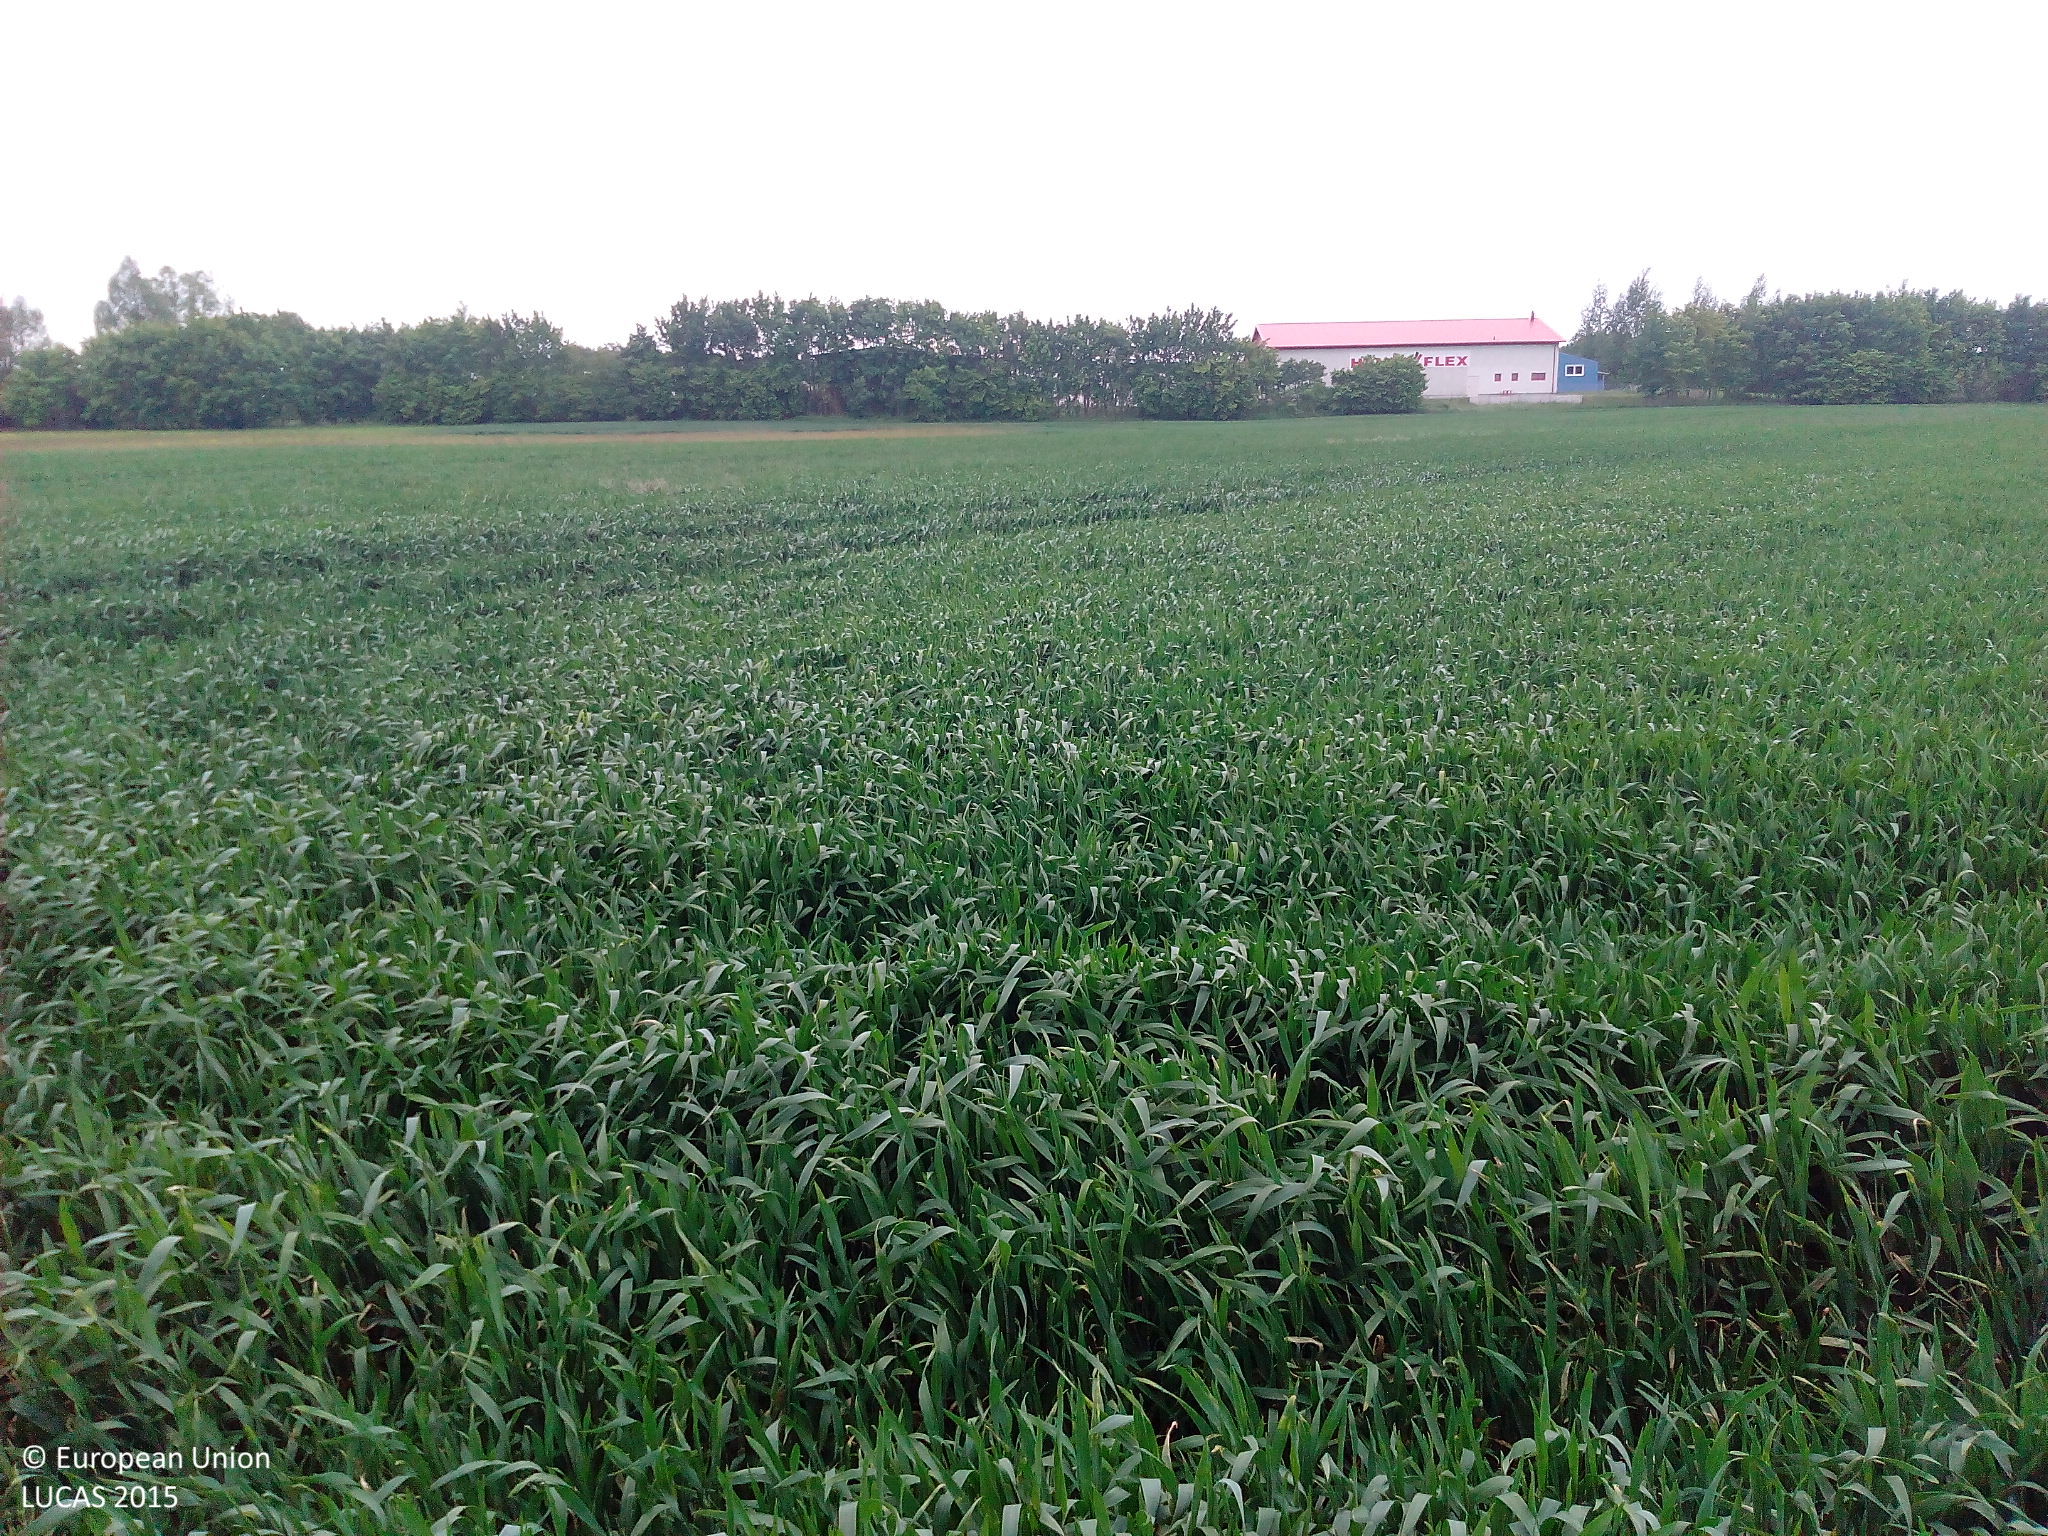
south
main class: Cropland
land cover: Common wheat
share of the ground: > 75 %
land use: Agriculture (excluding fallow land and kitchen gardens)
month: June
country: DE
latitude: 54.3642
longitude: 13.3081
